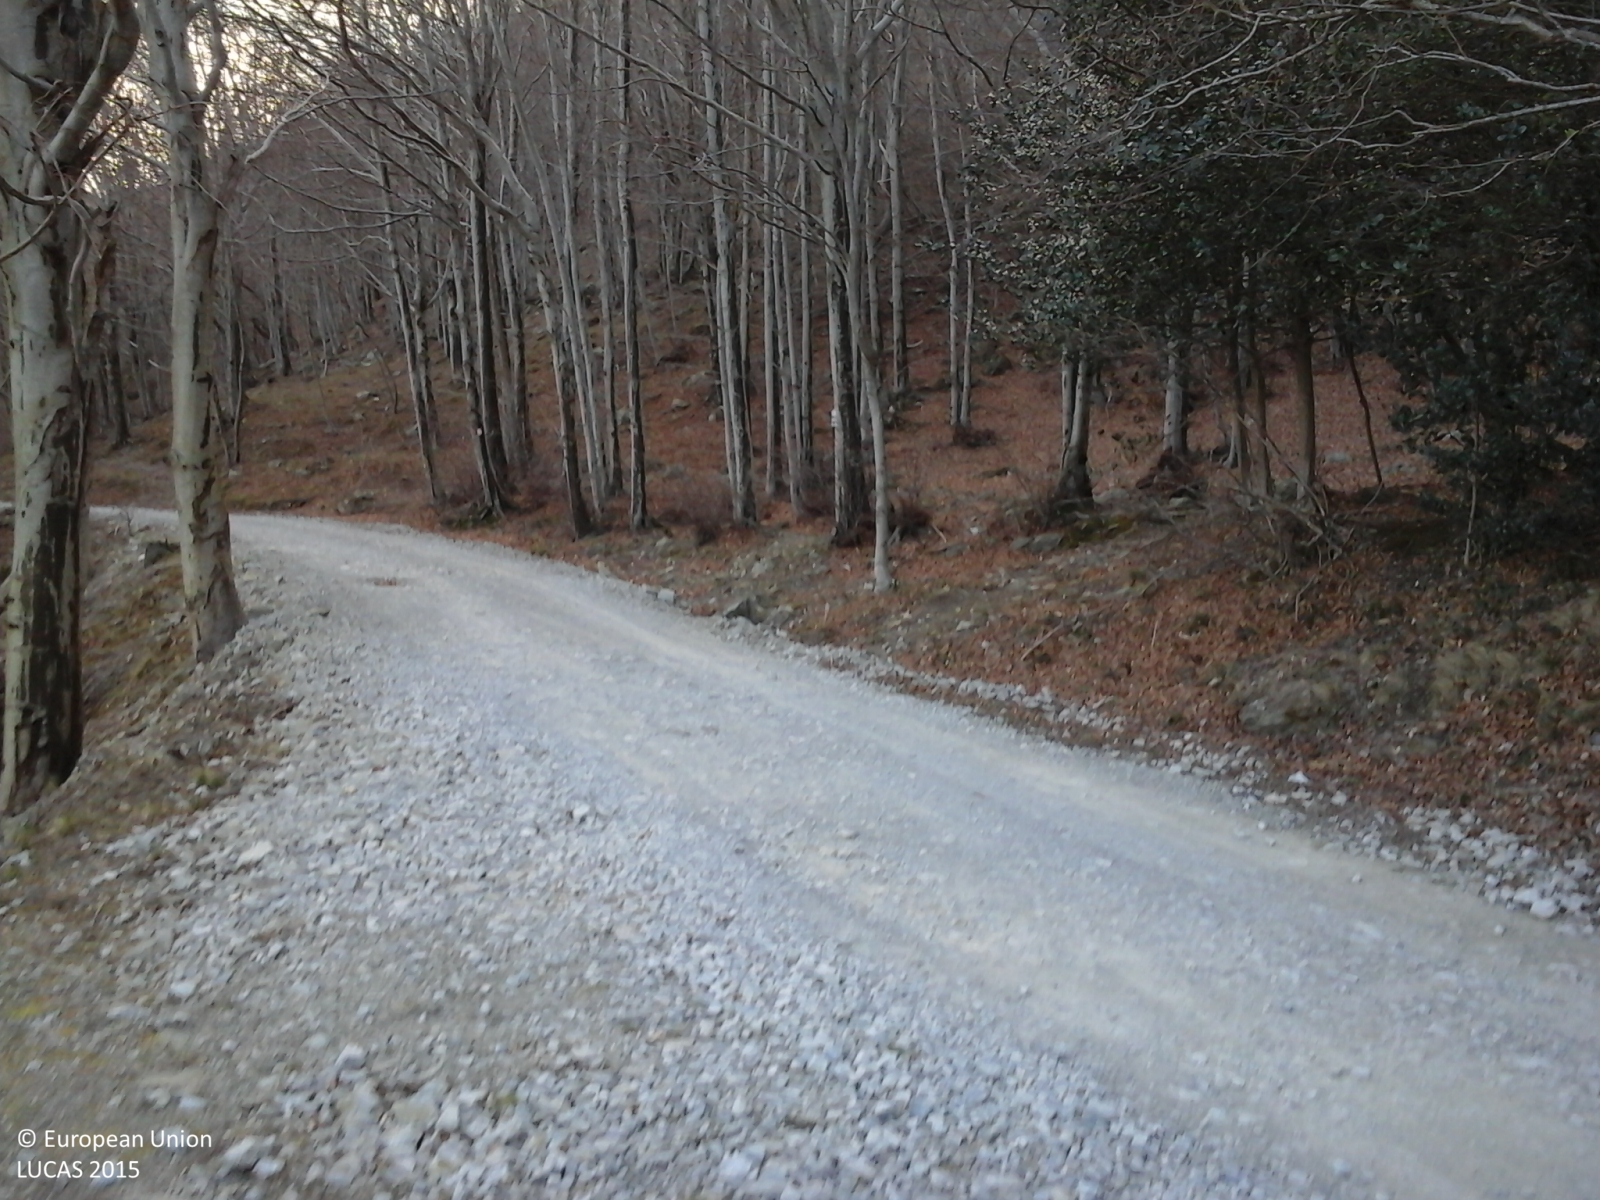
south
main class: Woodland
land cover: Broadleaved woodland
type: mesophytic deciduous forest
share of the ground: > 75 %
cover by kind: broadleaved forest trees 100 %
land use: Forestry
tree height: > 5 m
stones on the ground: 10 - 25 %
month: January
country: IT
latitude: 44.2462
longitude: 8.2883
